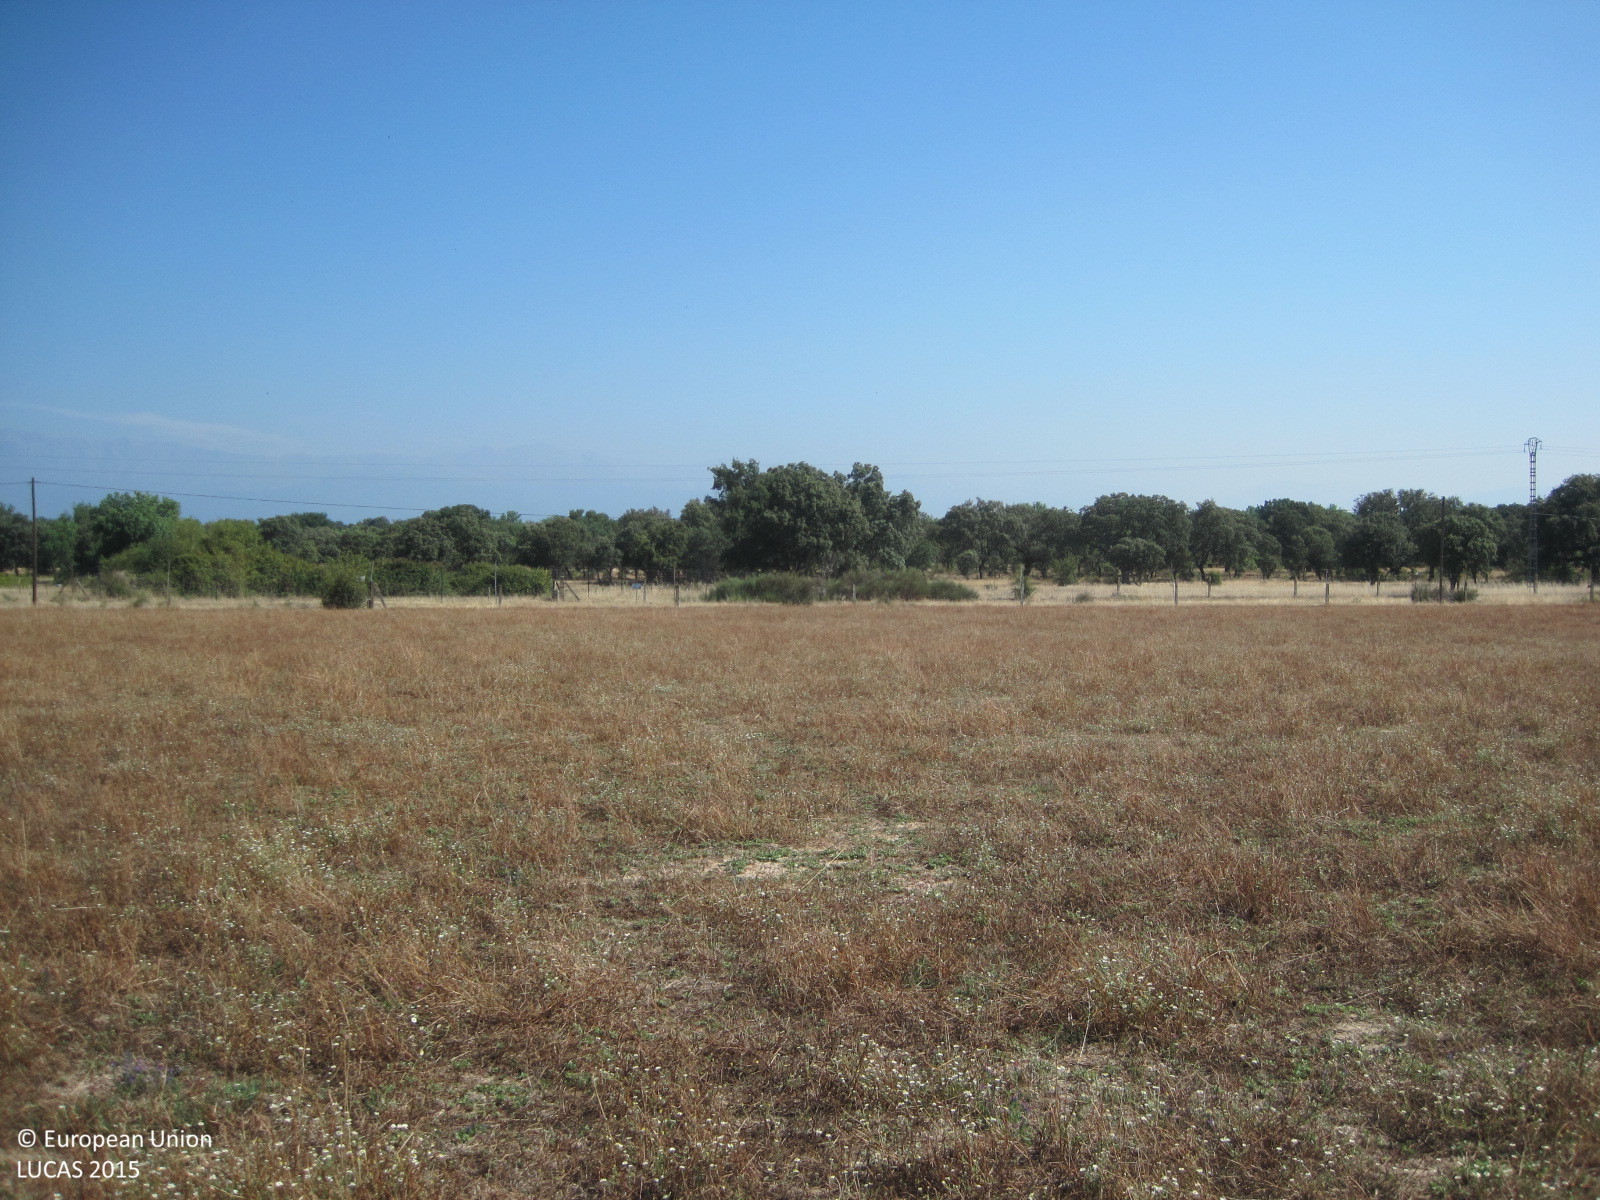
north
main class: Grassland
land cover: Grassland without tree/shrub cover
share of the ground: > 75 %
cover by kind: herbaceous plants 100 %
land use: Agriculture (excluding fallow land and kitchen gardens)
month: July
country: ES
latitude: 39.9836
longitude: -5.1482
